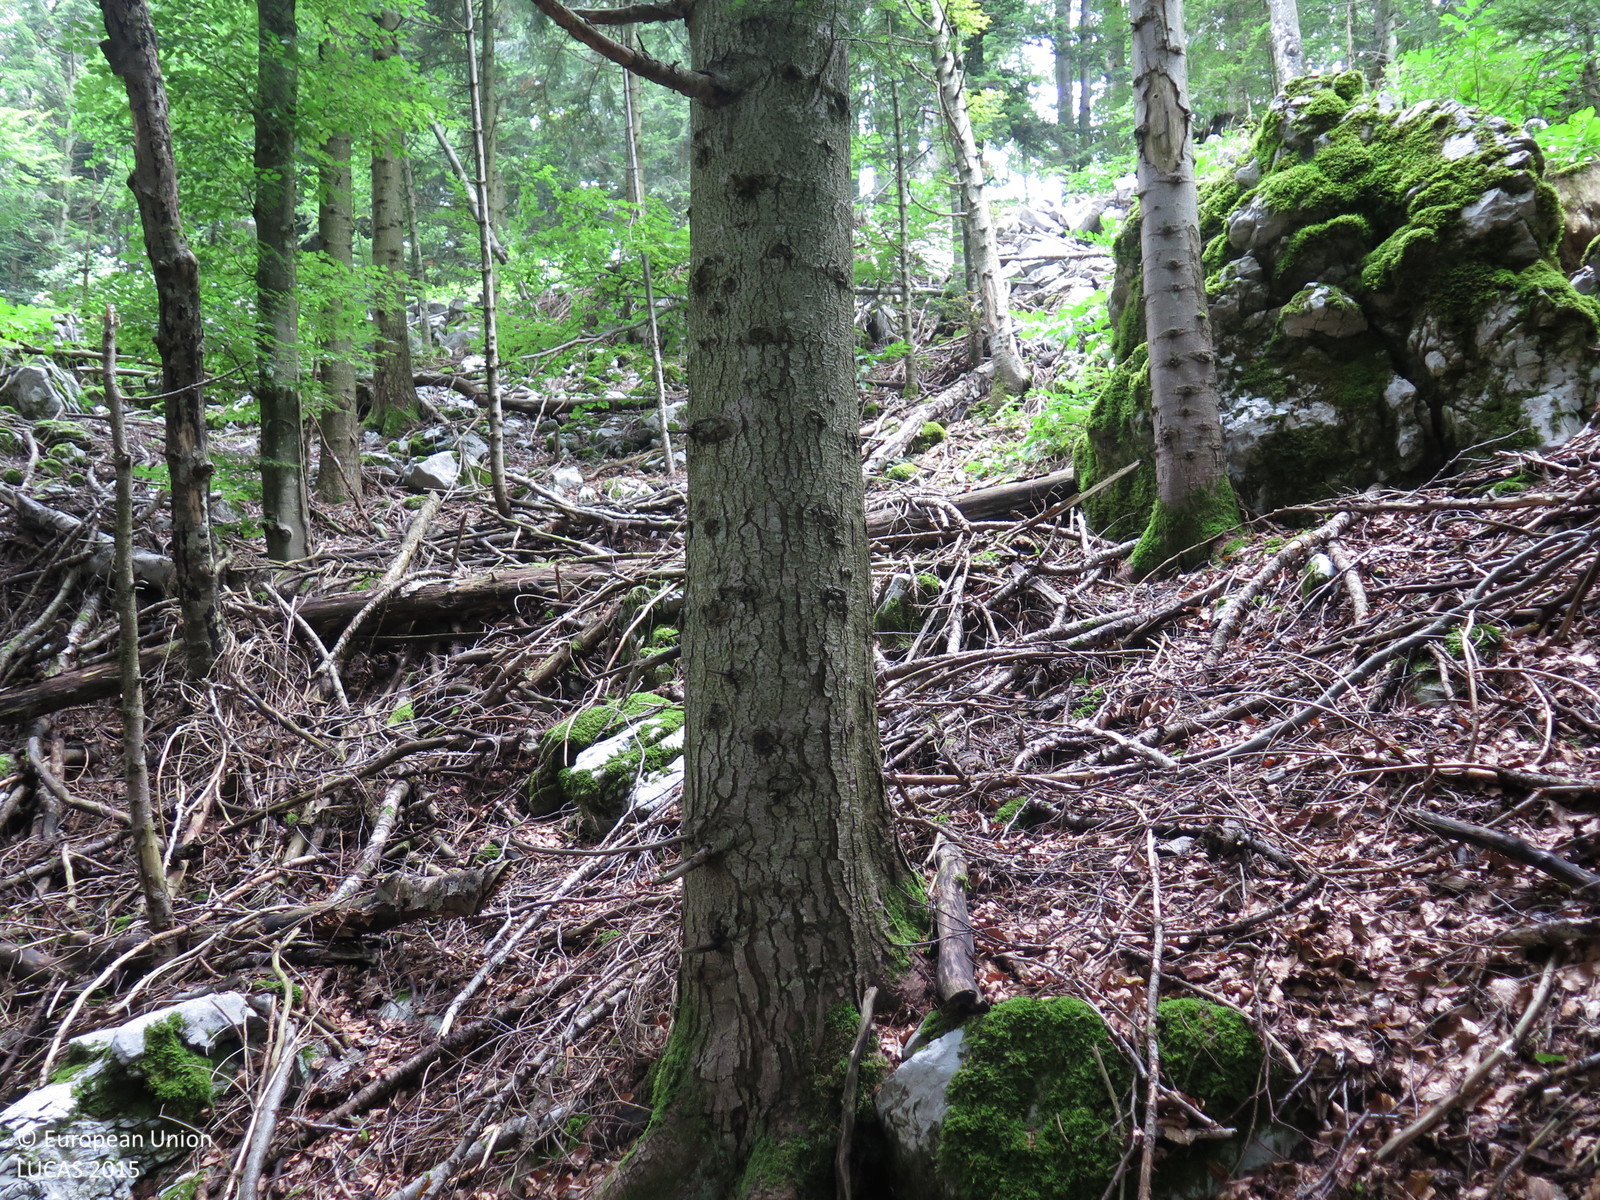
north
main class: Woodland
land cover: Other coniferous woodland
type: alpine coniferous forest
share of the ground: > 75 %
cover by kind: coniferous forest trees 75 %, broadleaved forest trees 25 %
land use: Forestry
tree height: > 5 m
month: August
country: HR
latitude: 45.0808
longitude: 14.9617
